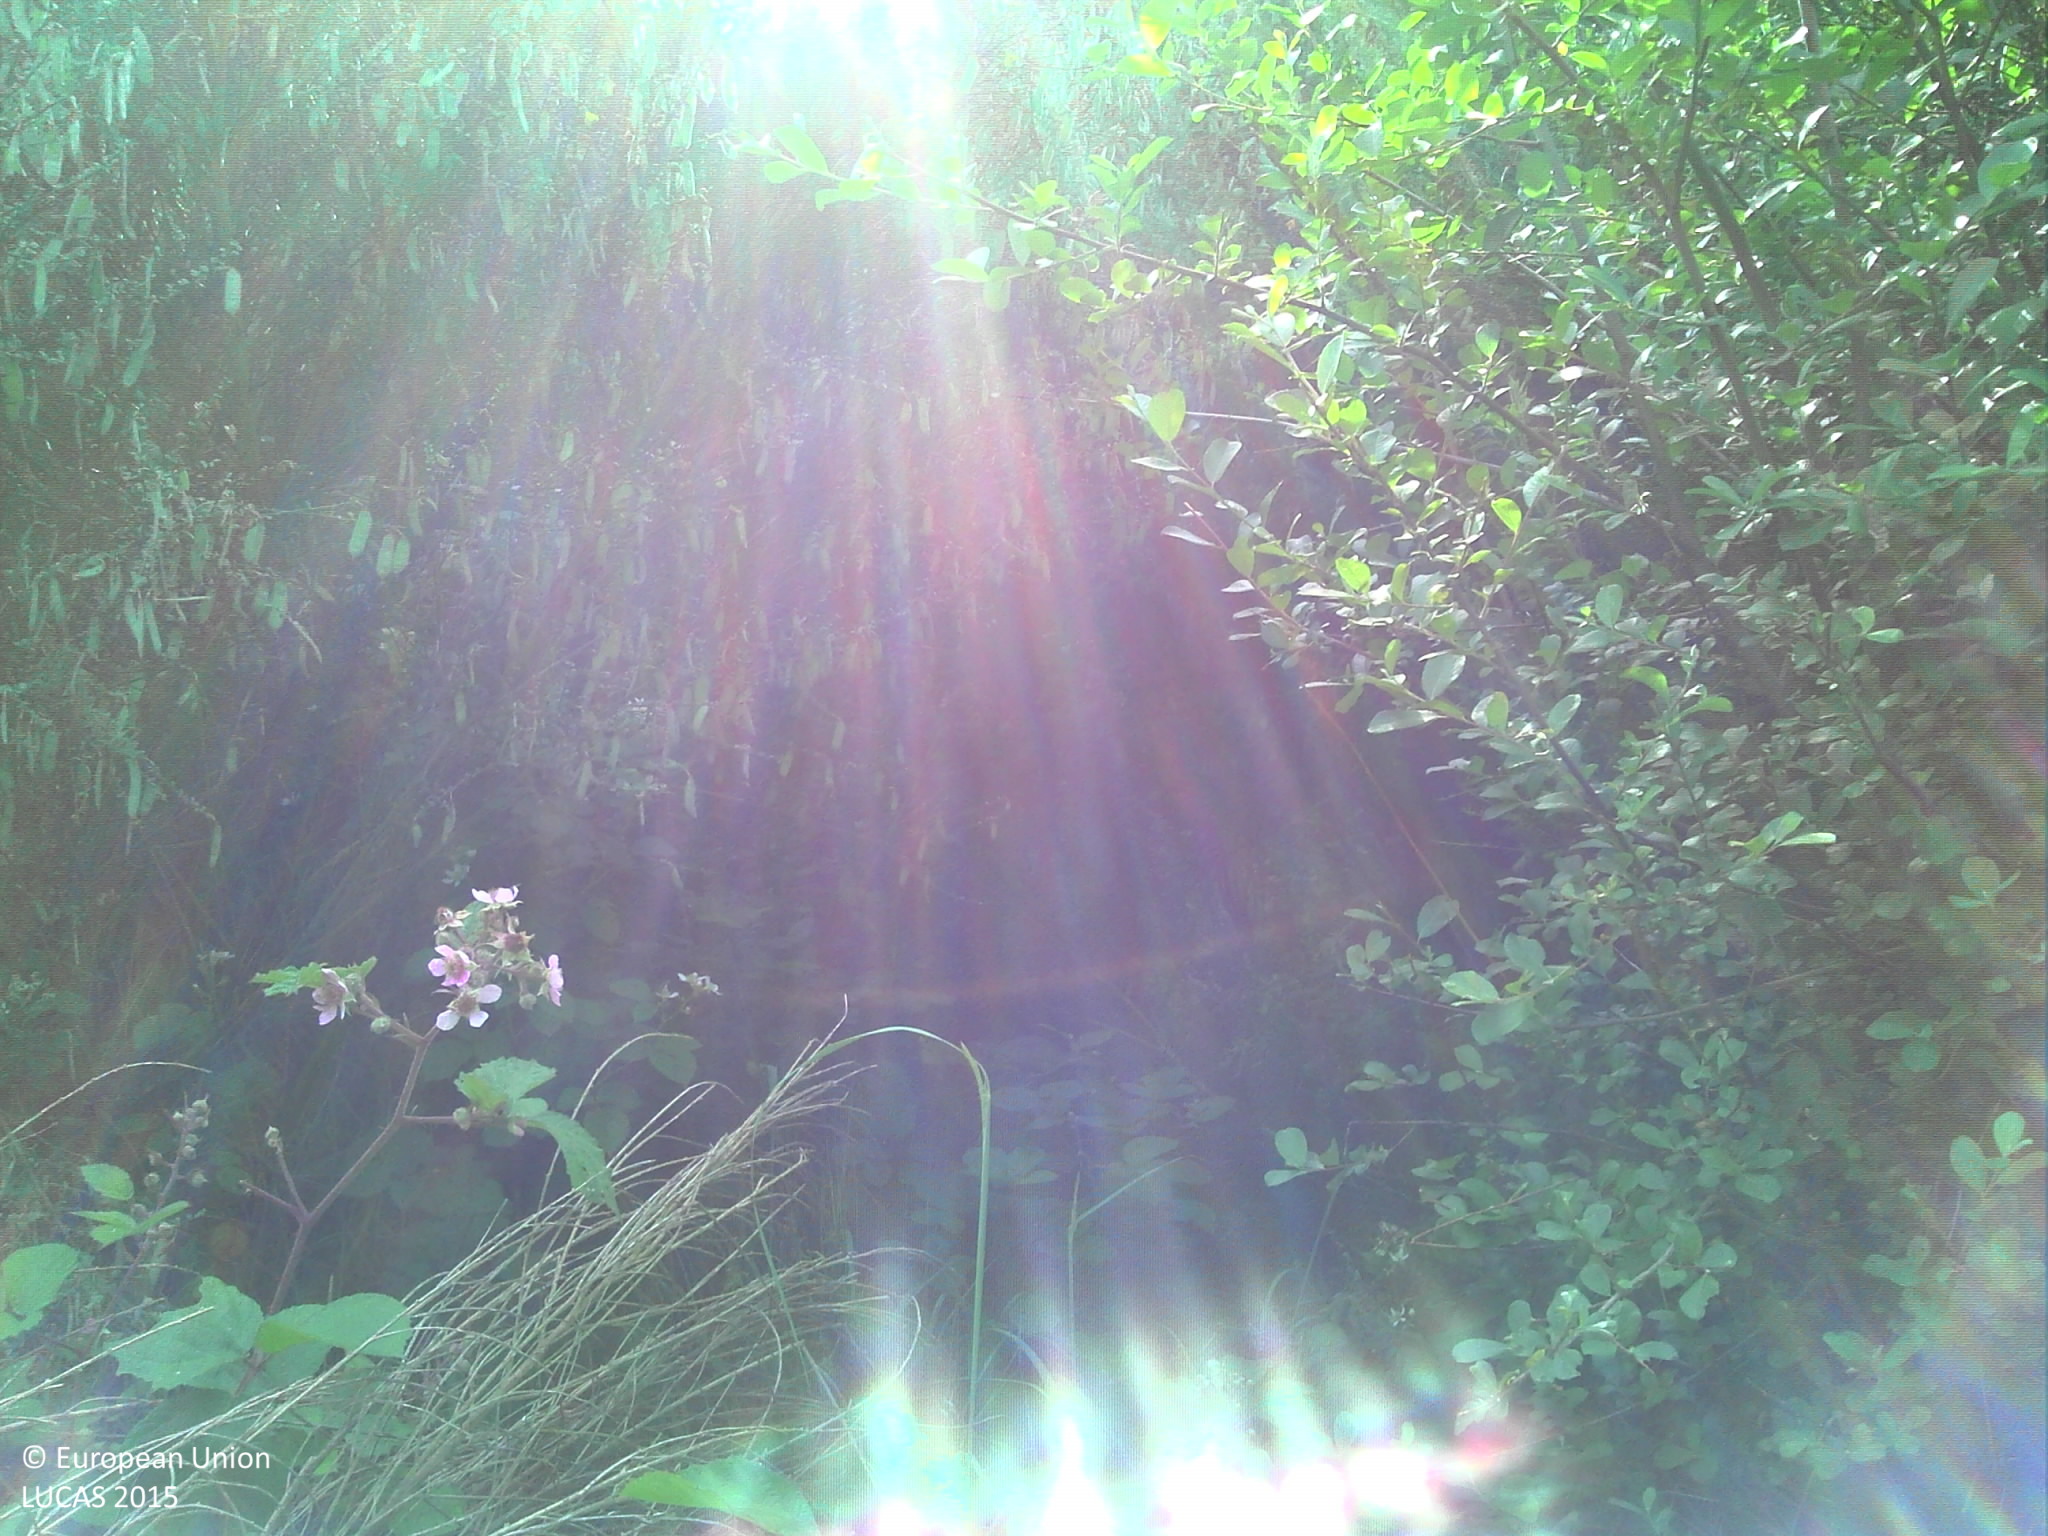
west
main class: Grassland
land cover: Spontaneously vegetated surfaces
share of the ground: > 75 %
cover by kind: herbaceous plants 100 %
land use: Semi-natural and natural areas not in use
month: June
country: FR
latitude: 49.2779
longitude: 1.1406
